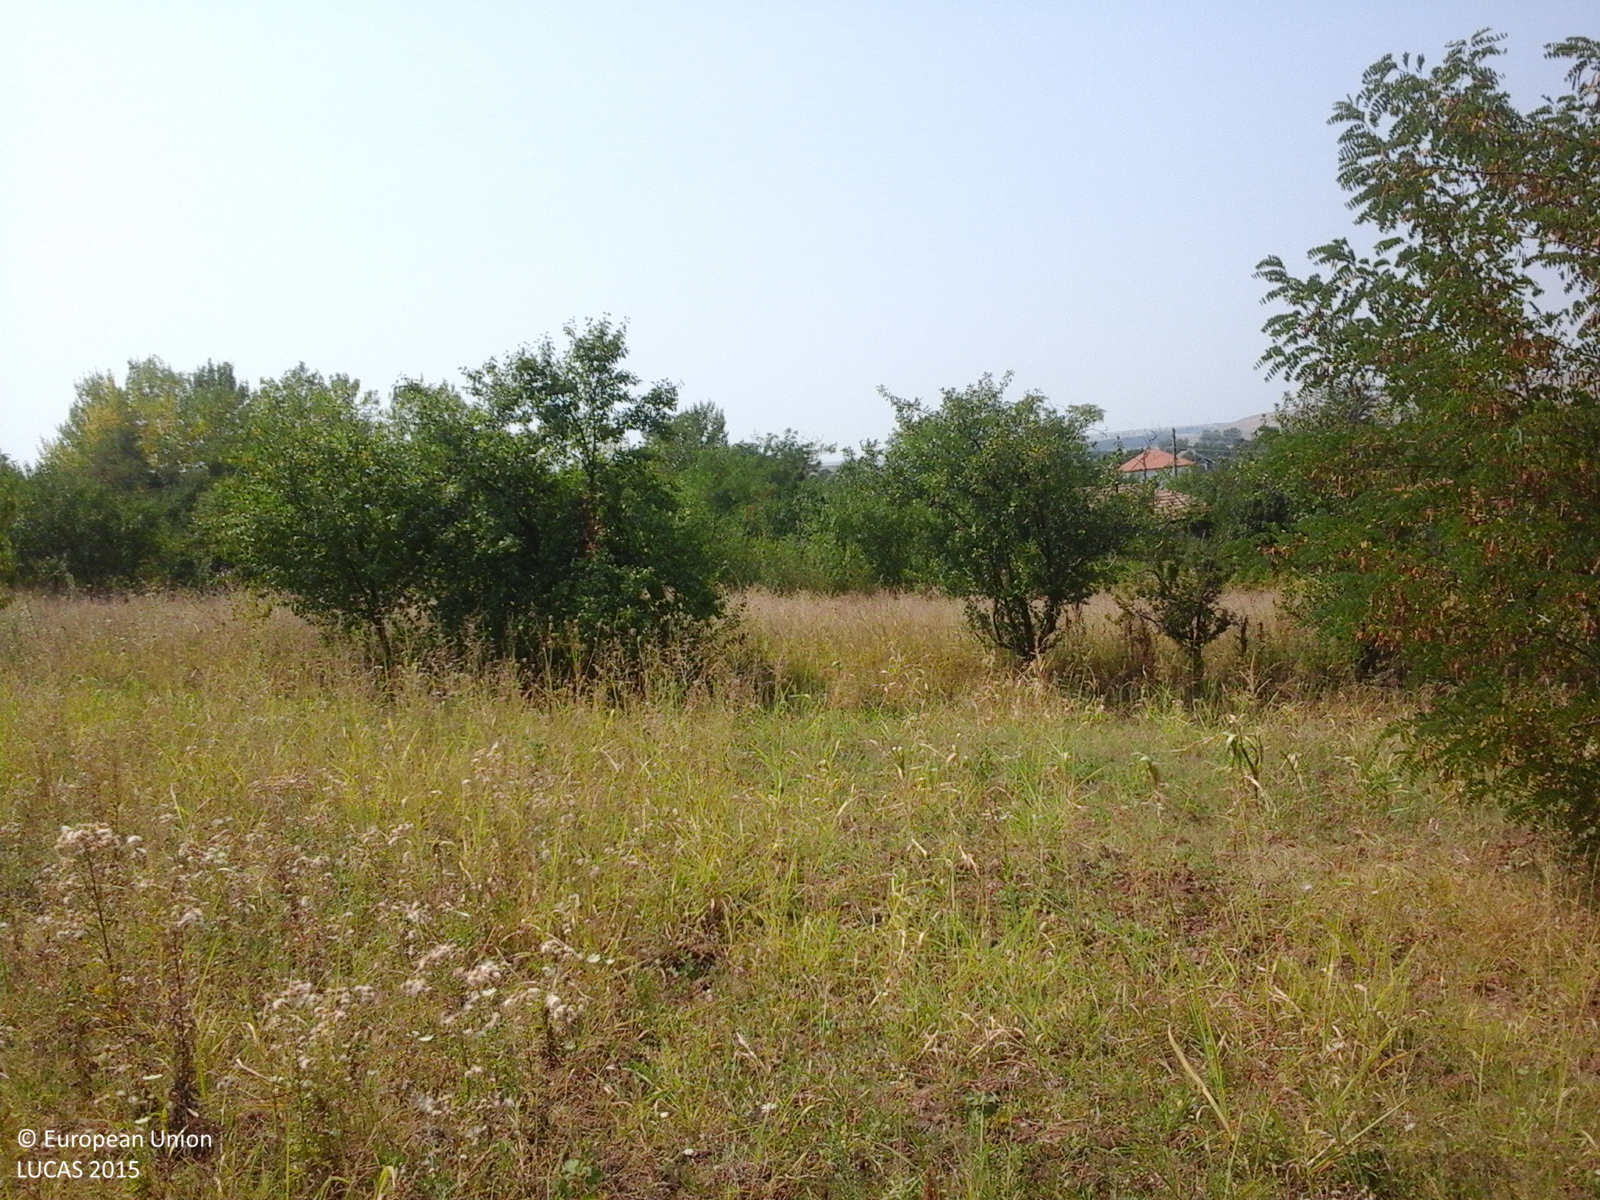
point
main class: Grassland
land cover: Grassland without tree/shrub cover
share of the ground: > 75 %
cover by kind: herbaceous plants 100 %
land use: Agriculture (excluding fallow land and kitchen gardens)
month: August
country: RO
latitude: 44.3615
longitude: 23.6177
